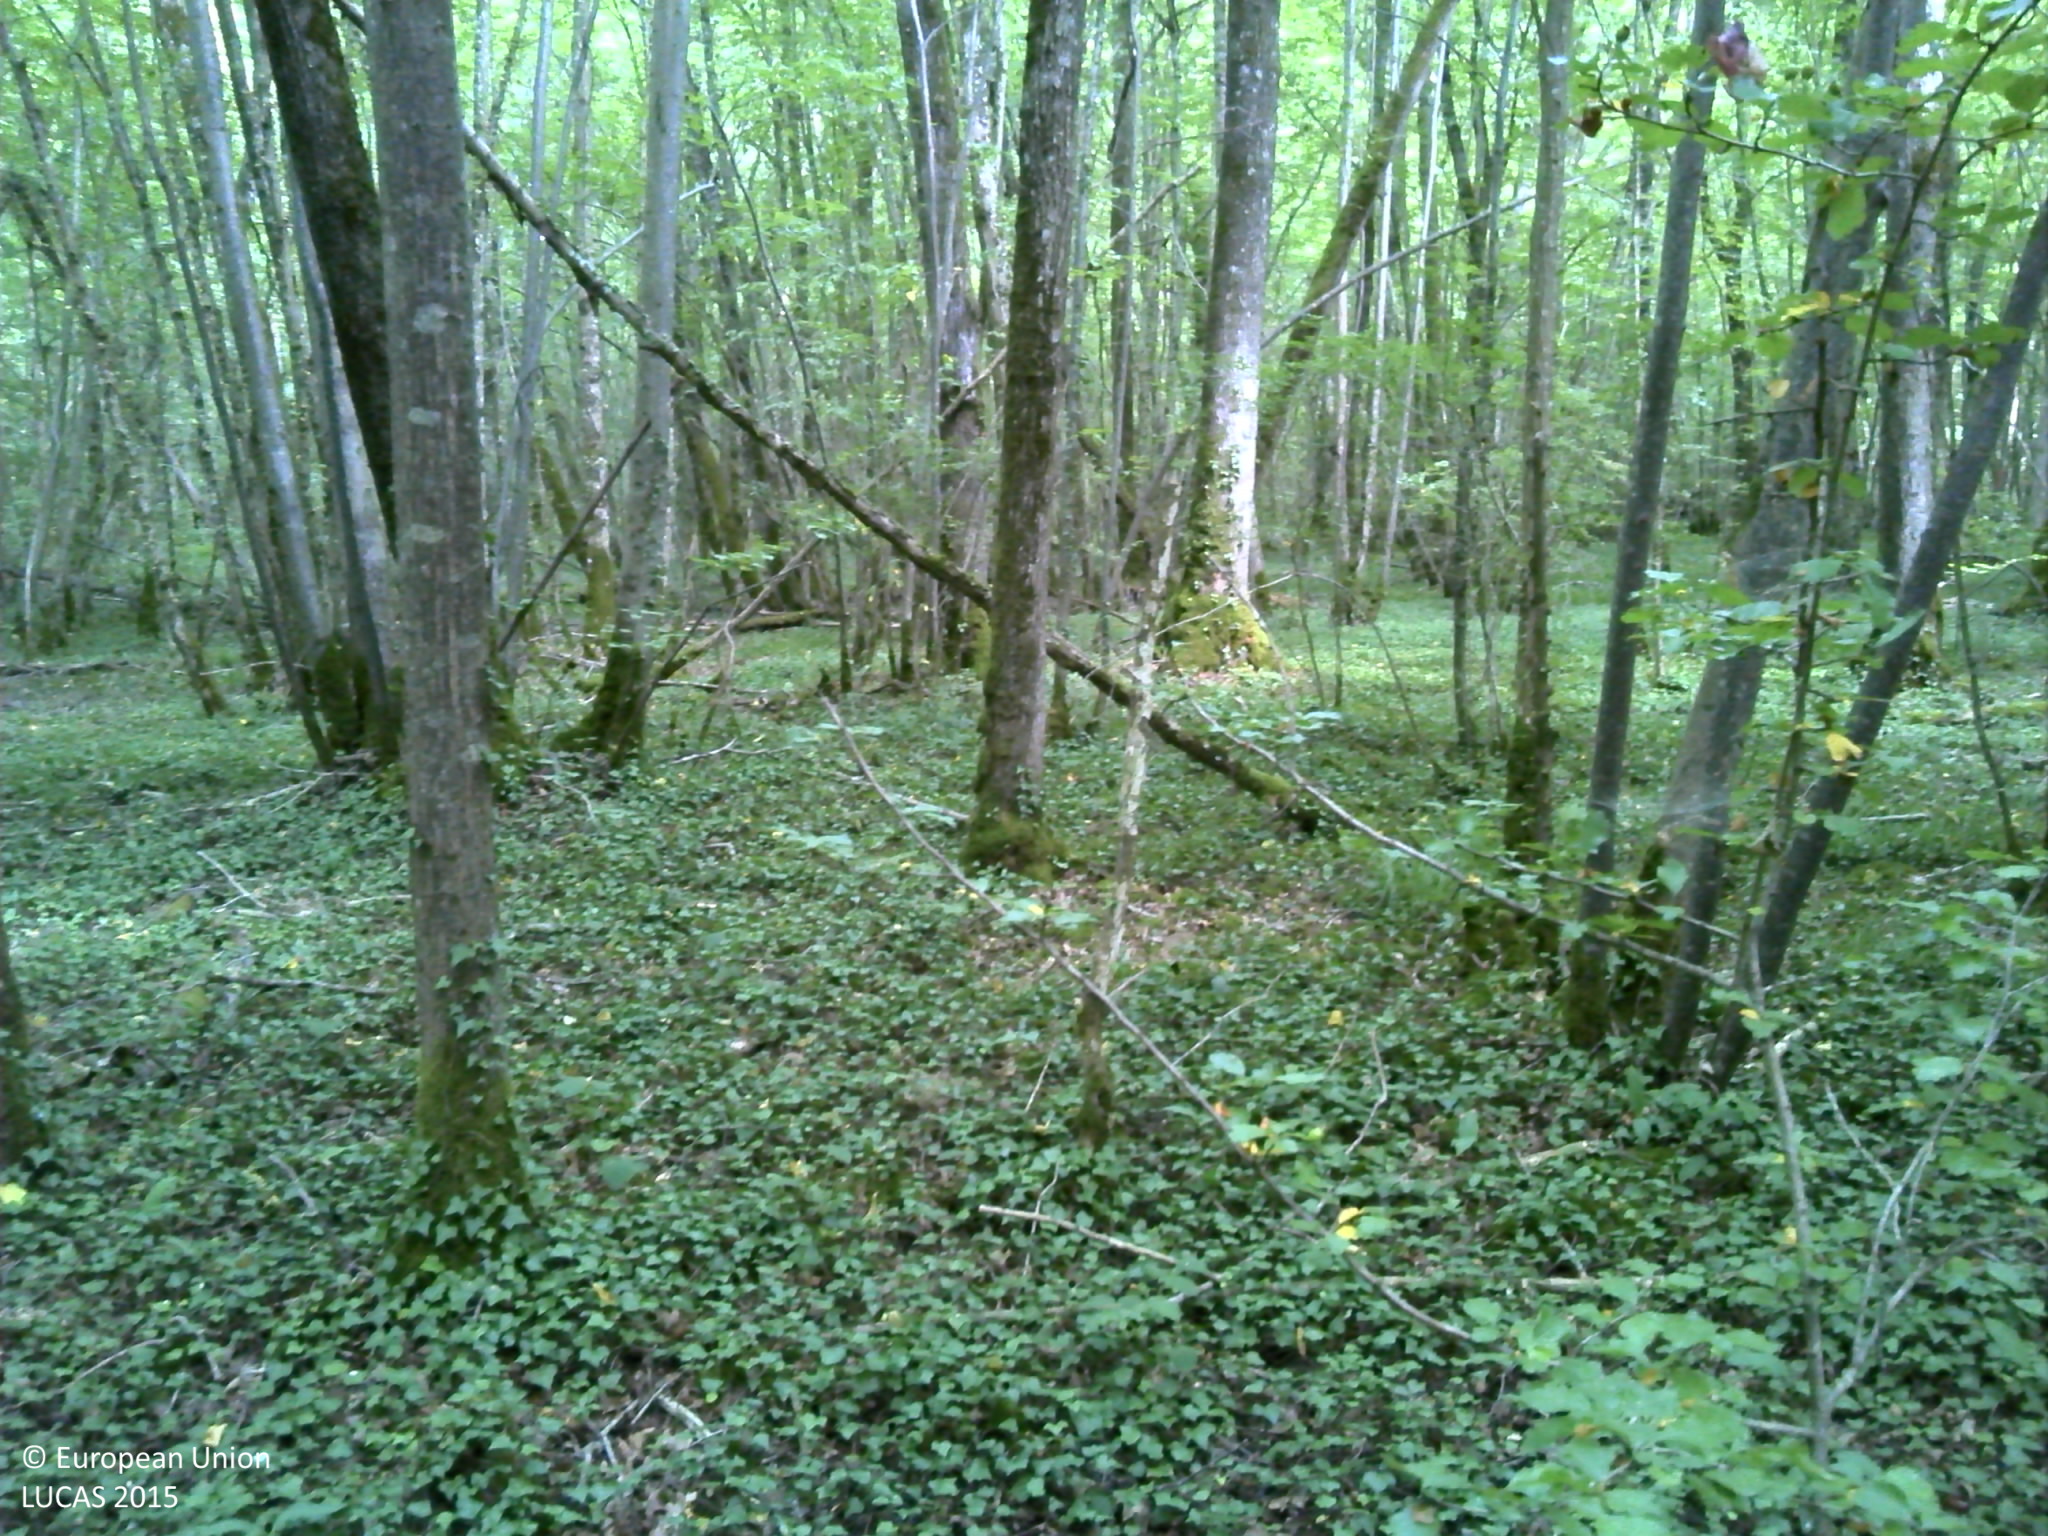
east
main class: Woodland
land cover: Broadleaved woodland
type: beech forest
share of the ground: > 75 %
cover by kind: broadleaved forest trees 95 %, herbaceous plants 5 %
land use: Forestry
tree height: > 5 m
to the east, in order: Broadleaved woodland
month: July
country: FR
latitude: 48.6008
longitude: 4.6954
